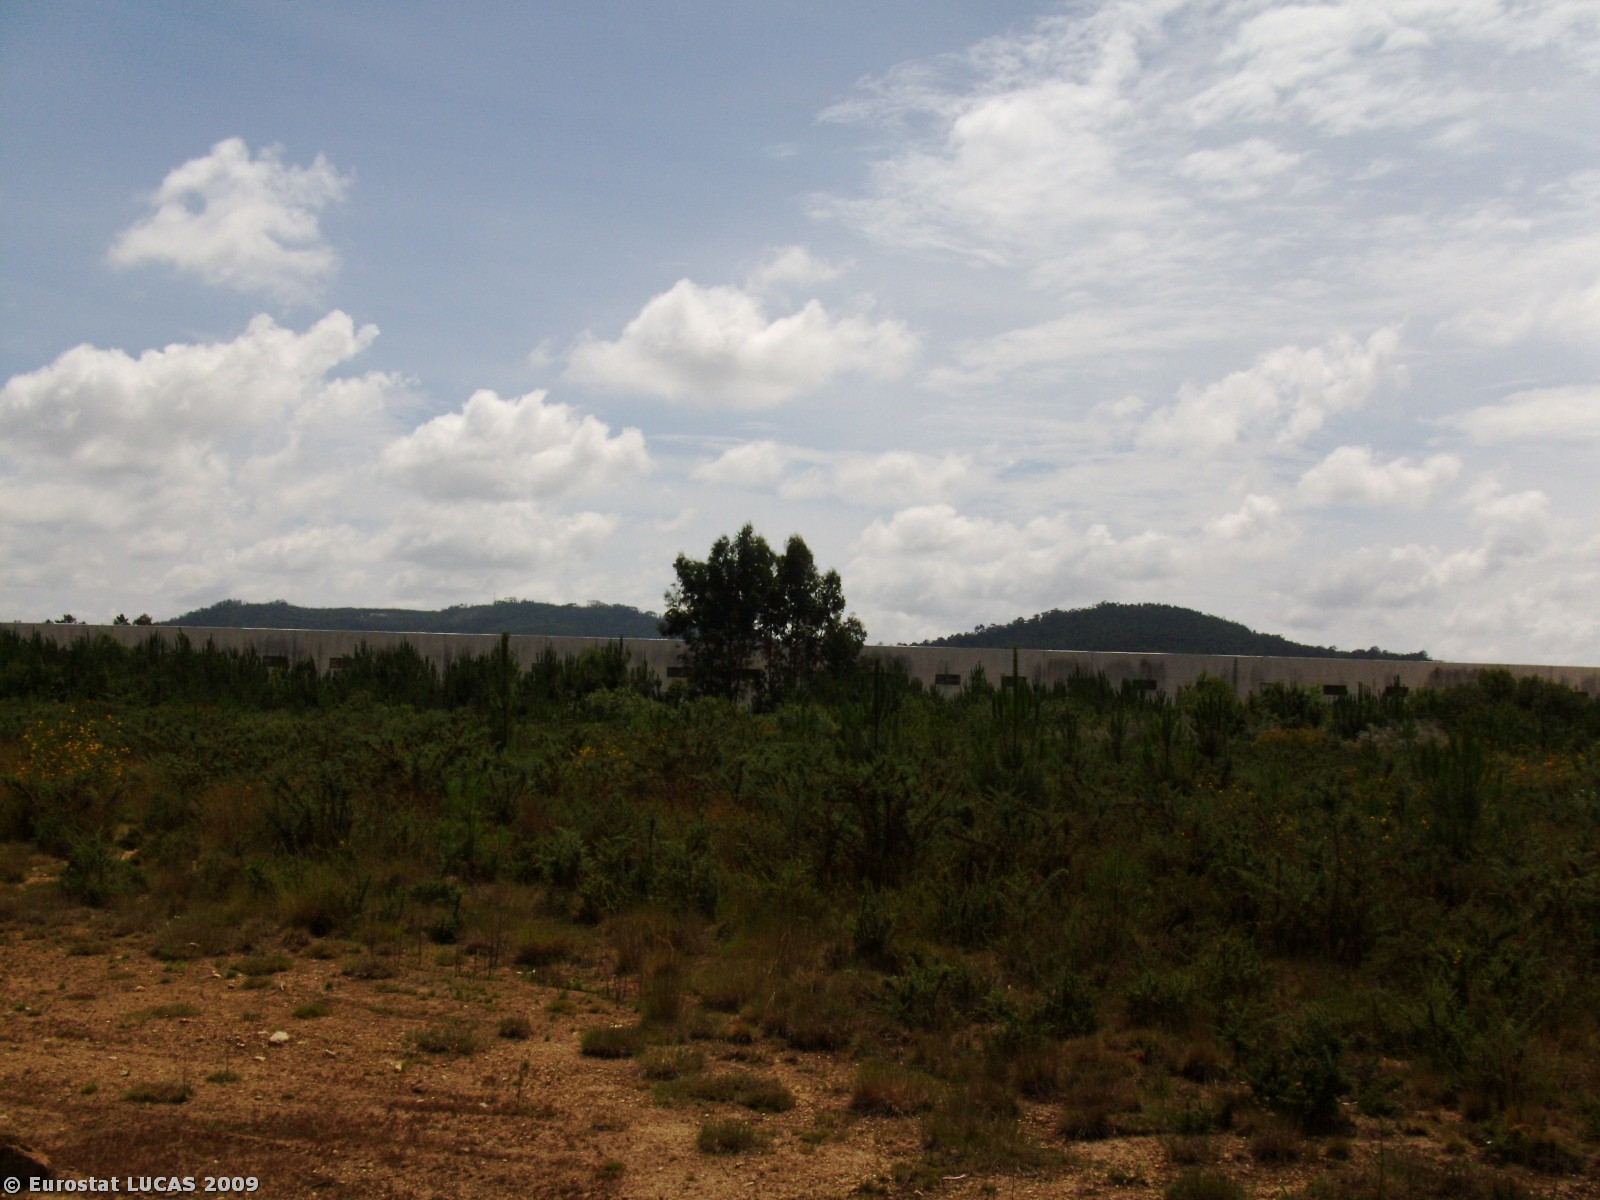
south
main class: Grassland
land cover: Spontaneously vegetated surfaces
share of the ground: 10 - 25 %
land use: Unused
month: June
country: PT
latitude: 41.5272
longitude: -8.5782
